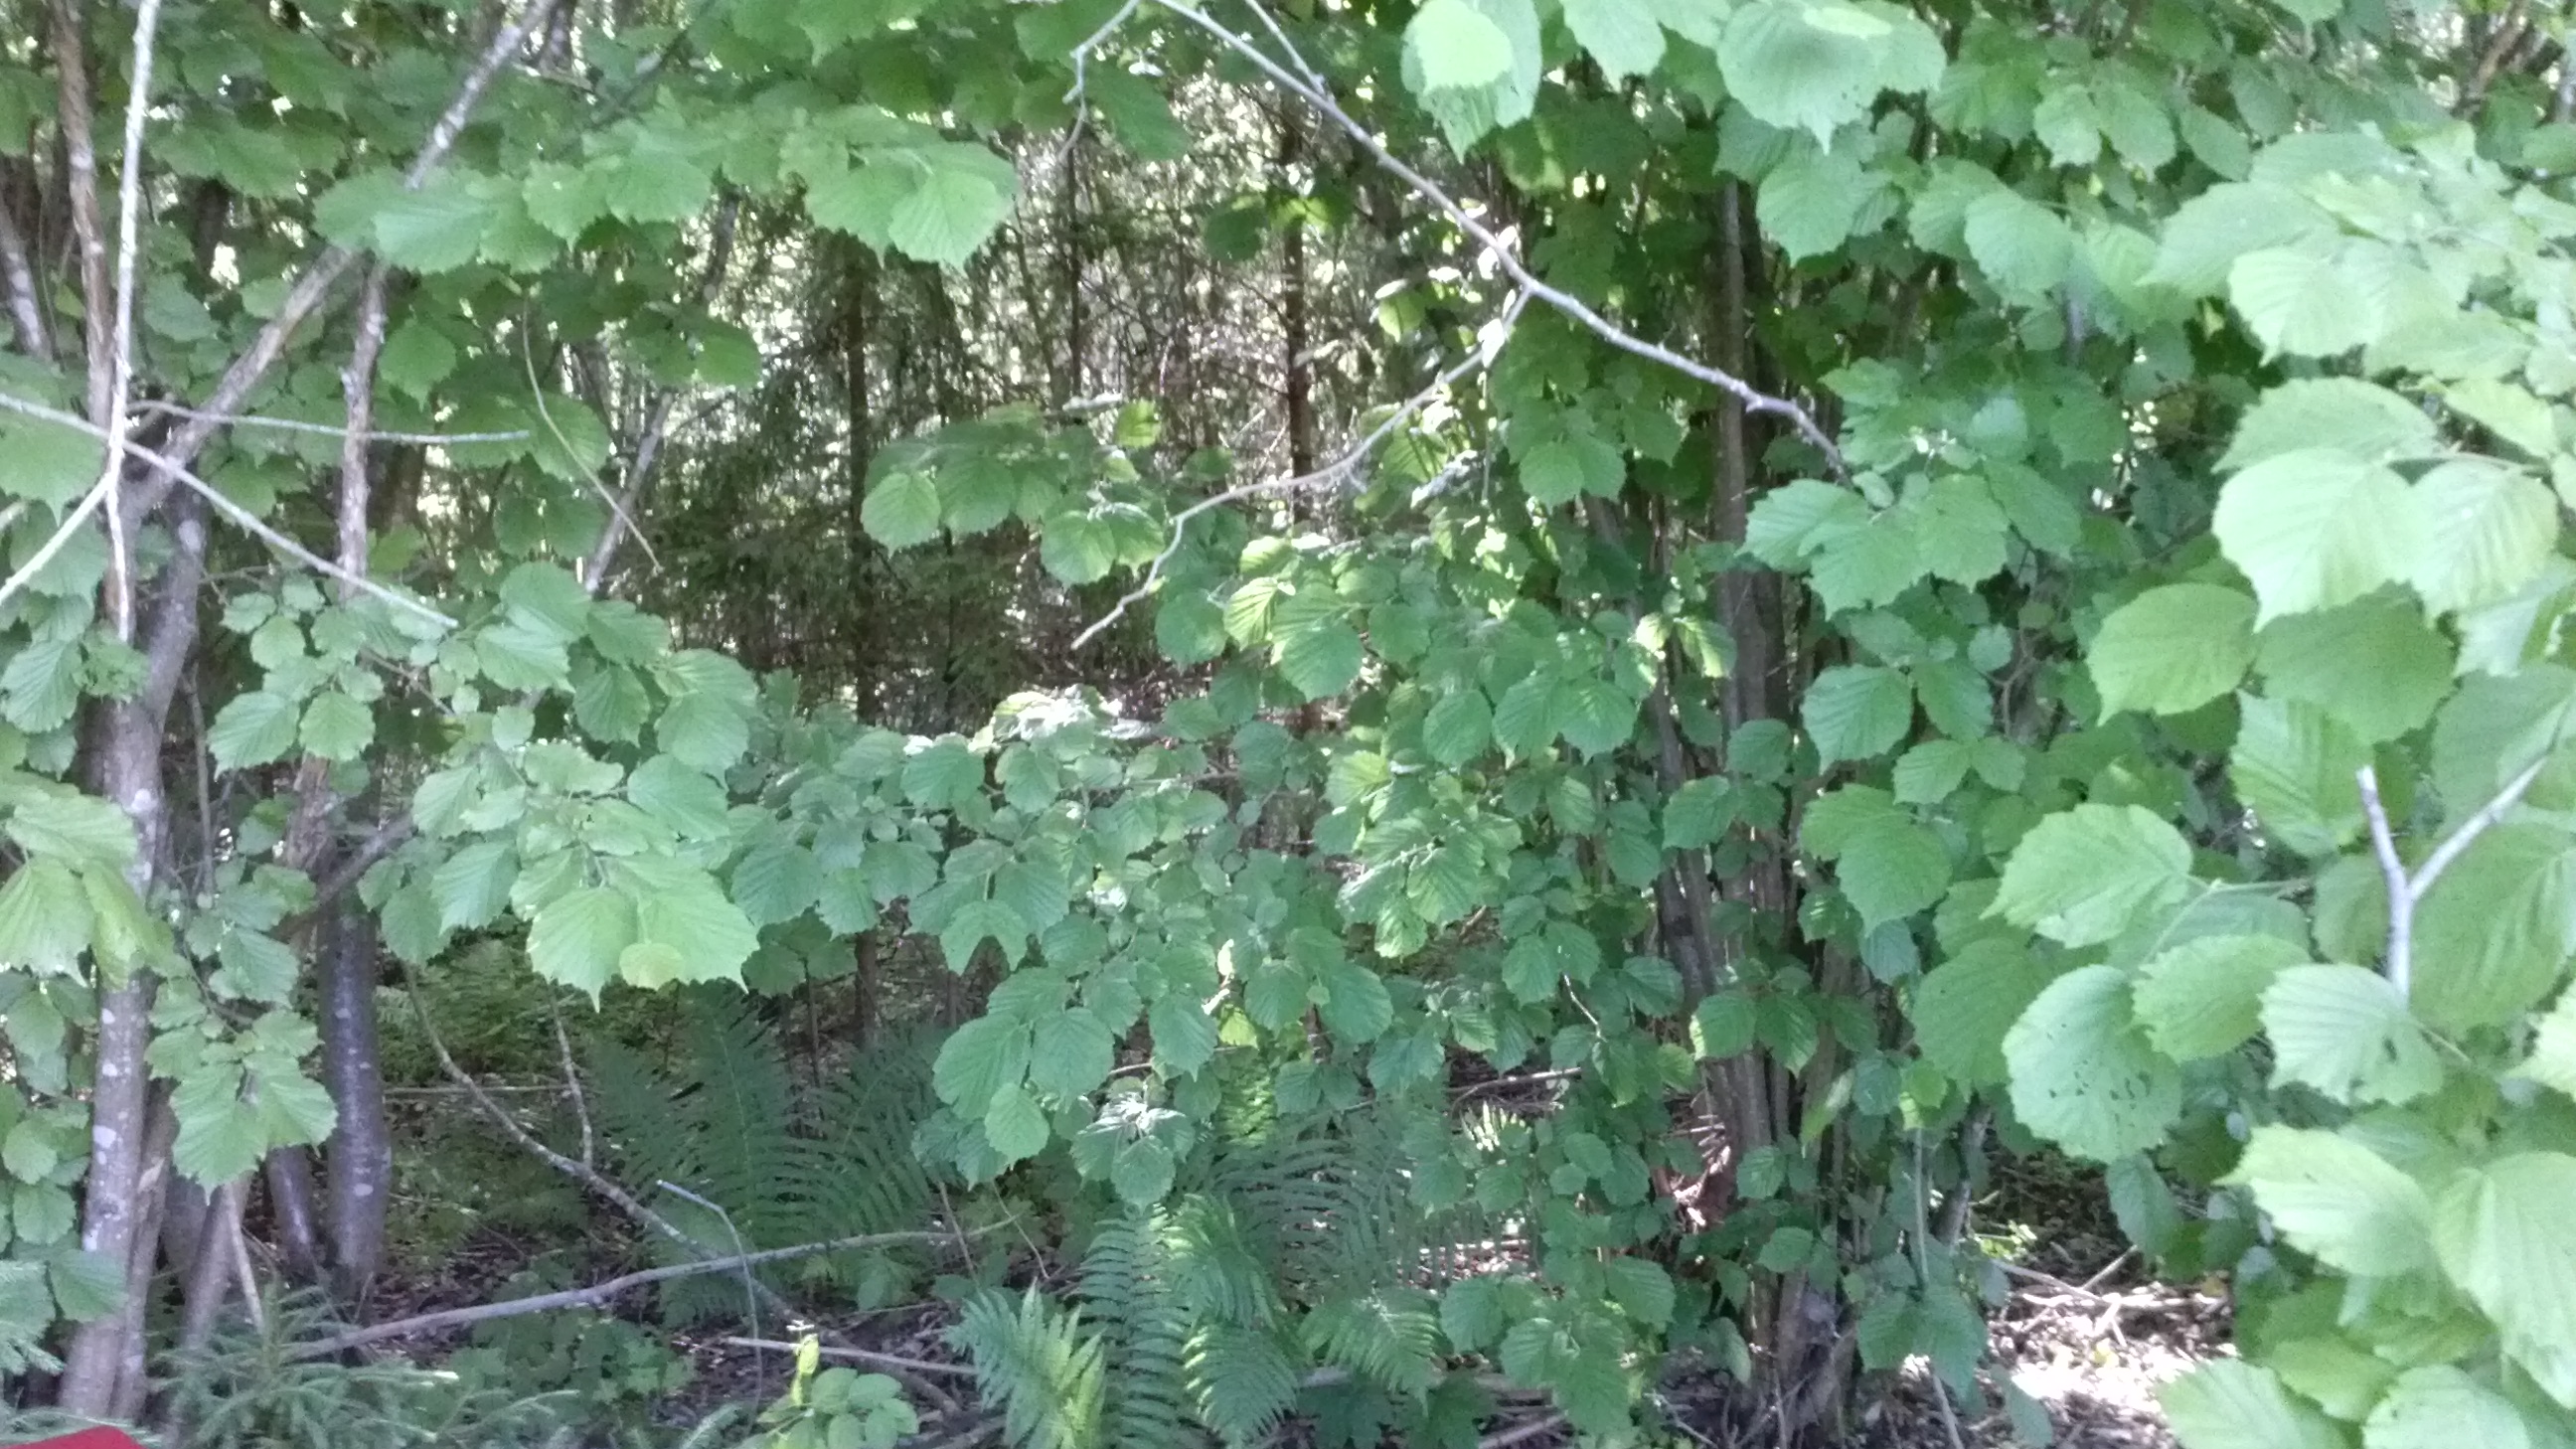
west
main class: Woodland
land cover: Broadleaved woodland
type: non-riverine alder, birch or aspen forest
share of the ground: > 75 %
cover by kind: broadleaved forest trees 80 %, herbaceous plants 10 %, coniferous forest trees 5 %, shrubs 5 %
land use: Forestry
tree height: > 5 m
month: June
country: LV
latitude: 56.5172
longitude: 27.9254
